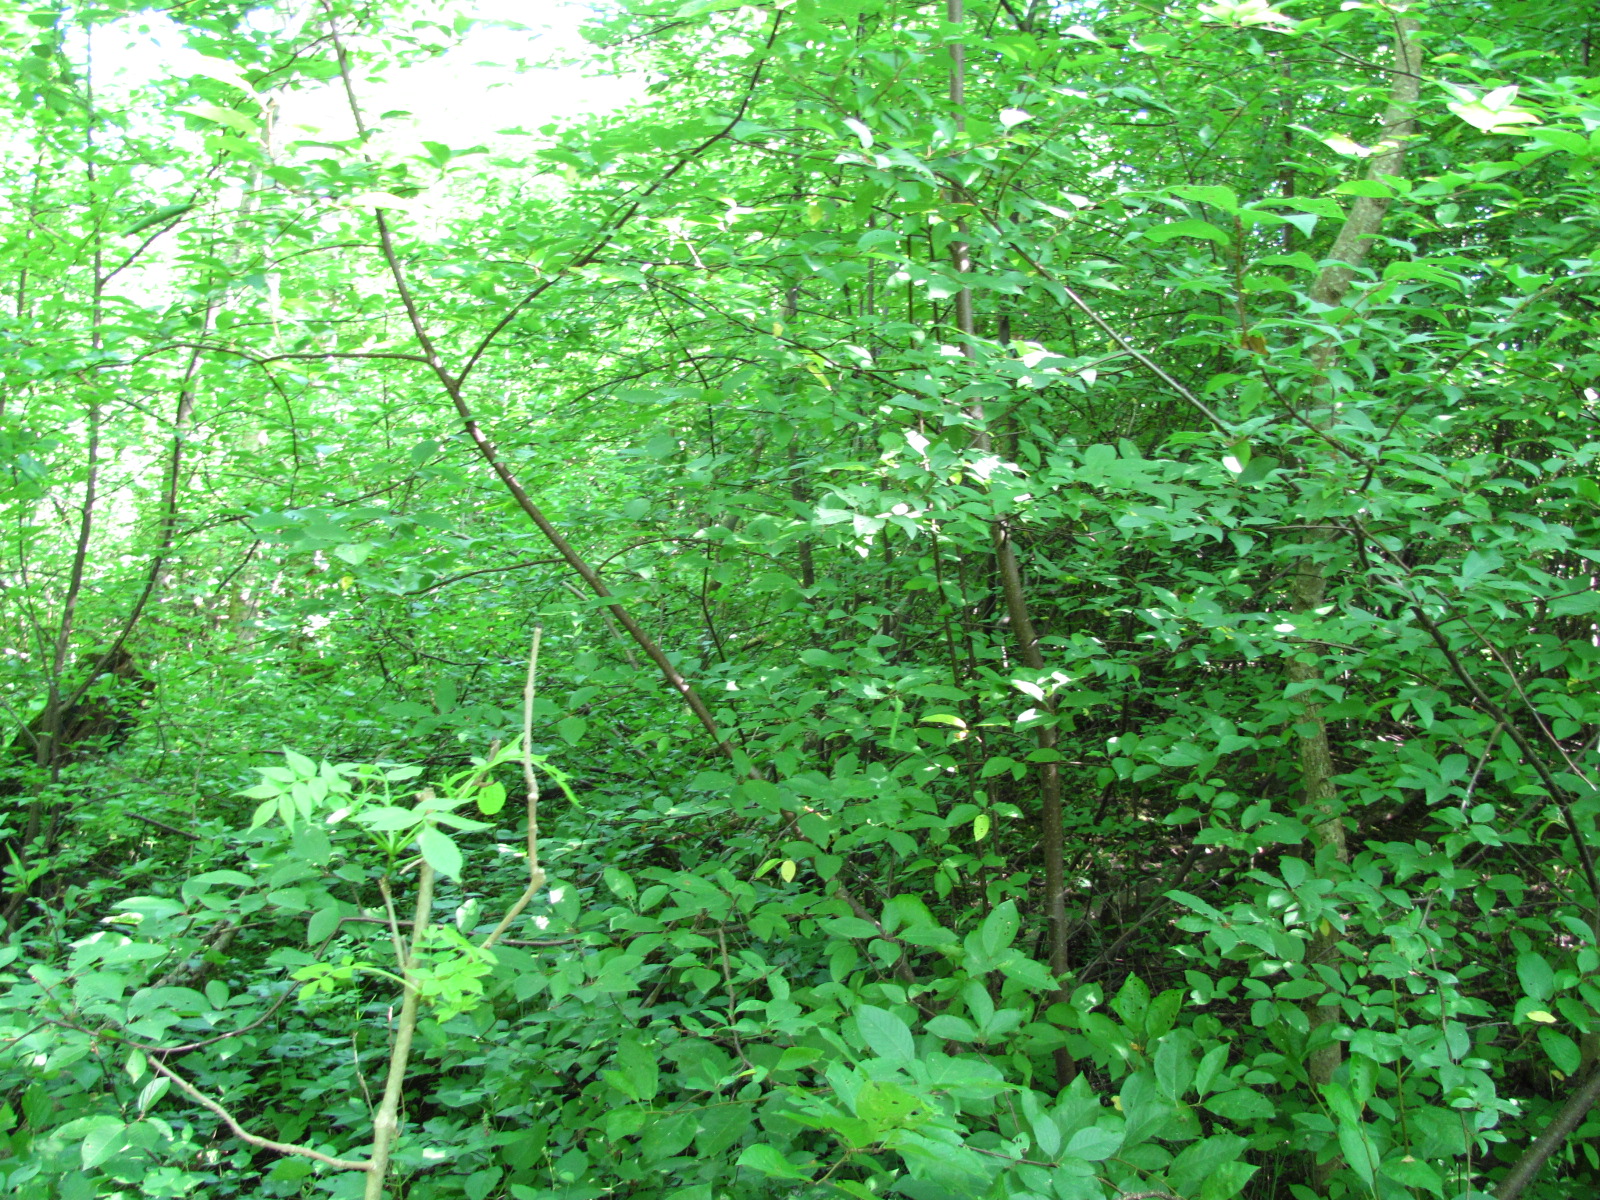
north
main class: Woodland
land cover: Broadleaved woodland
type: non-riverine alder, birch or aspen forest
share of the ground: > 75 %
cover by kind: broadleaved forest trees 100 %
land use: Forestry
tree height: > 5 m
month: June
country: LV
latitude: 56.3526
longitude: 23.9532
